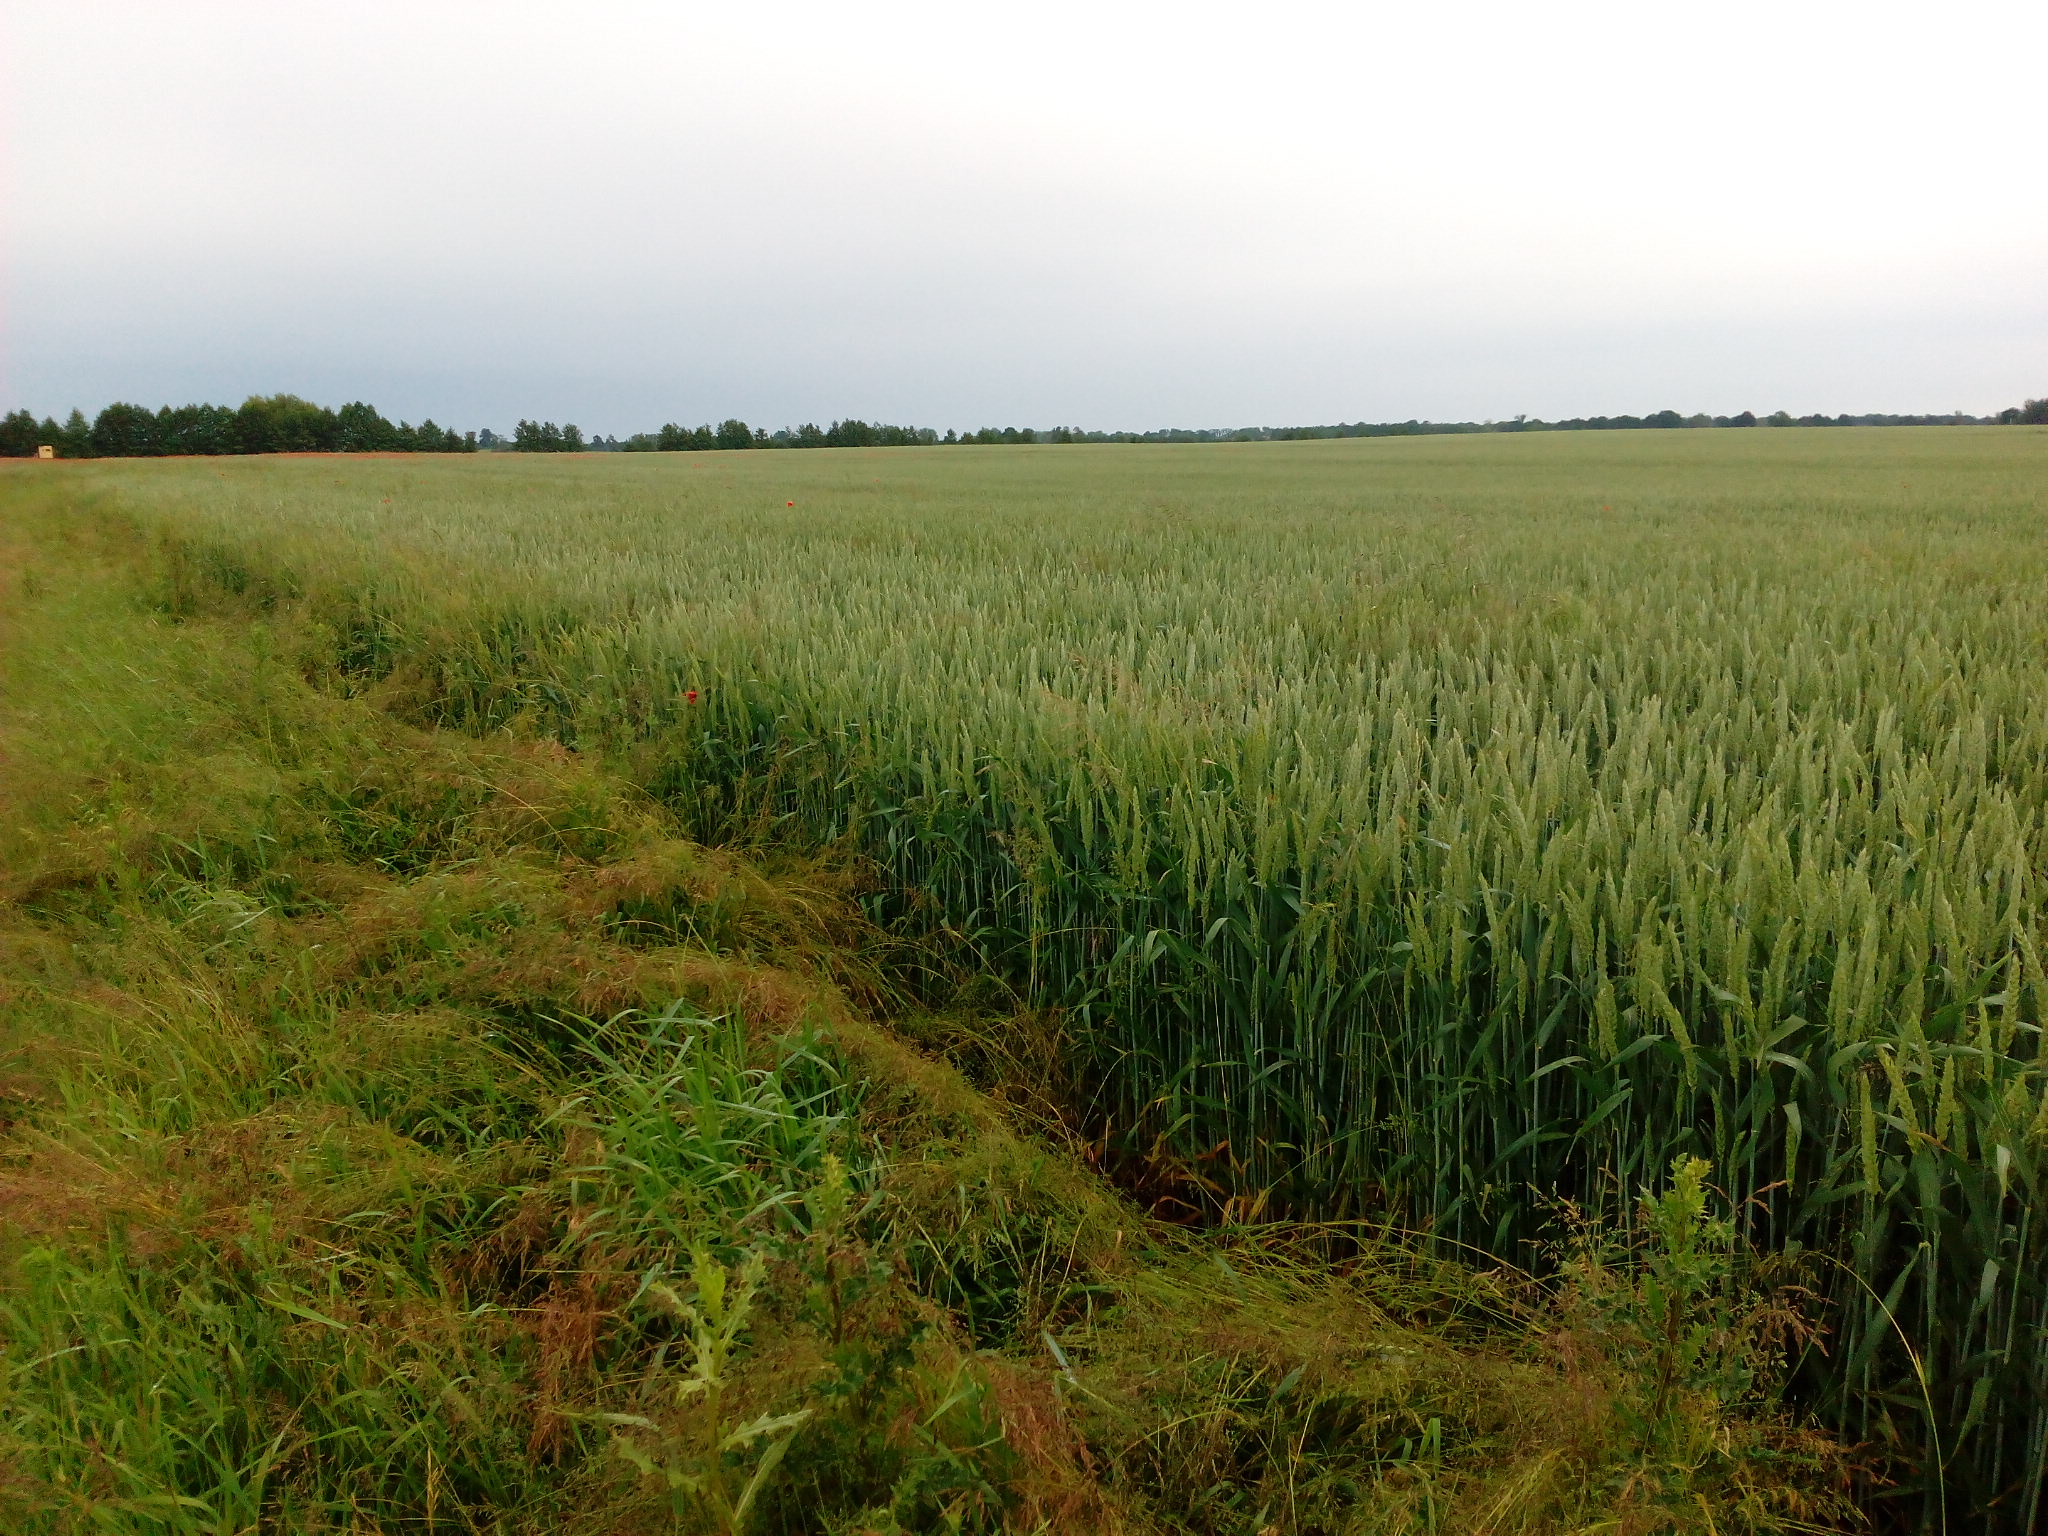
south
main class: Cropland
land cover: Common wheat
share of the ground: > 75 %
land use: Agriculture (excluding fallow land and kitchen gardens)
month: June
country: DE
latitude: 52.9827
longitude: 13.1723
